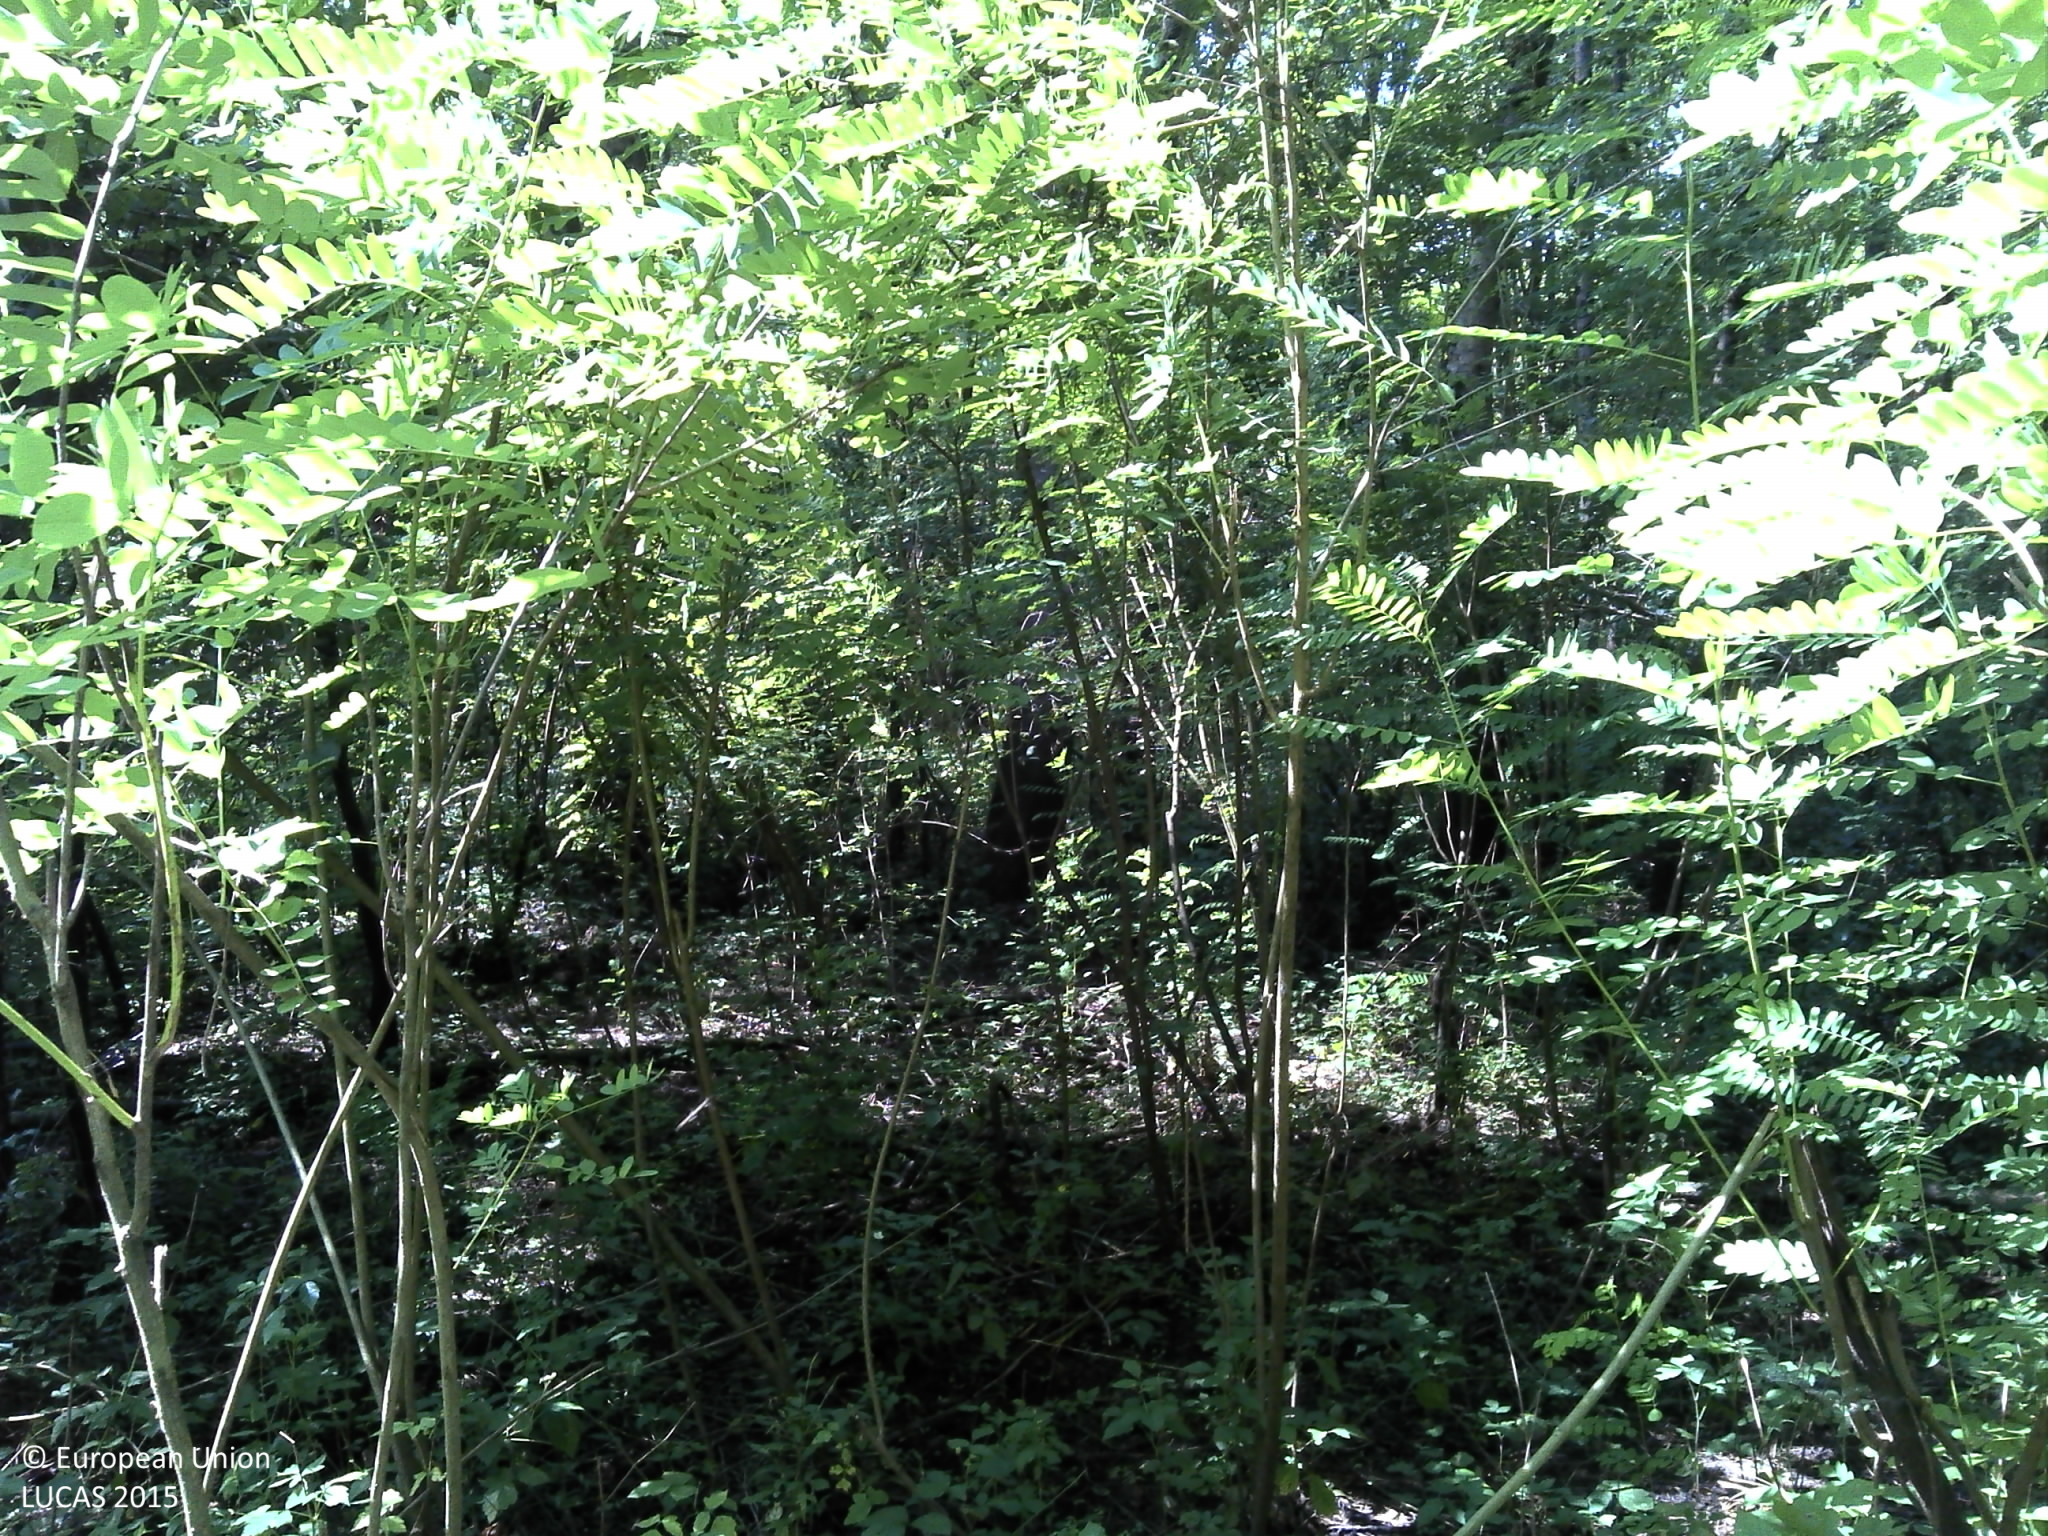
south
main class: Woodland
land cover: Broadleaved woodland
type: acidophilous oak and oak-birch forest
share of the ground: > 75 %
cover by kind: broadleaved forest trees 100 %
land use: Forestry
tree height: > 5 m
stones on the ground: < 10 %
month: August
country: HR
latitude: 45.4176
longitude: 16.7075
